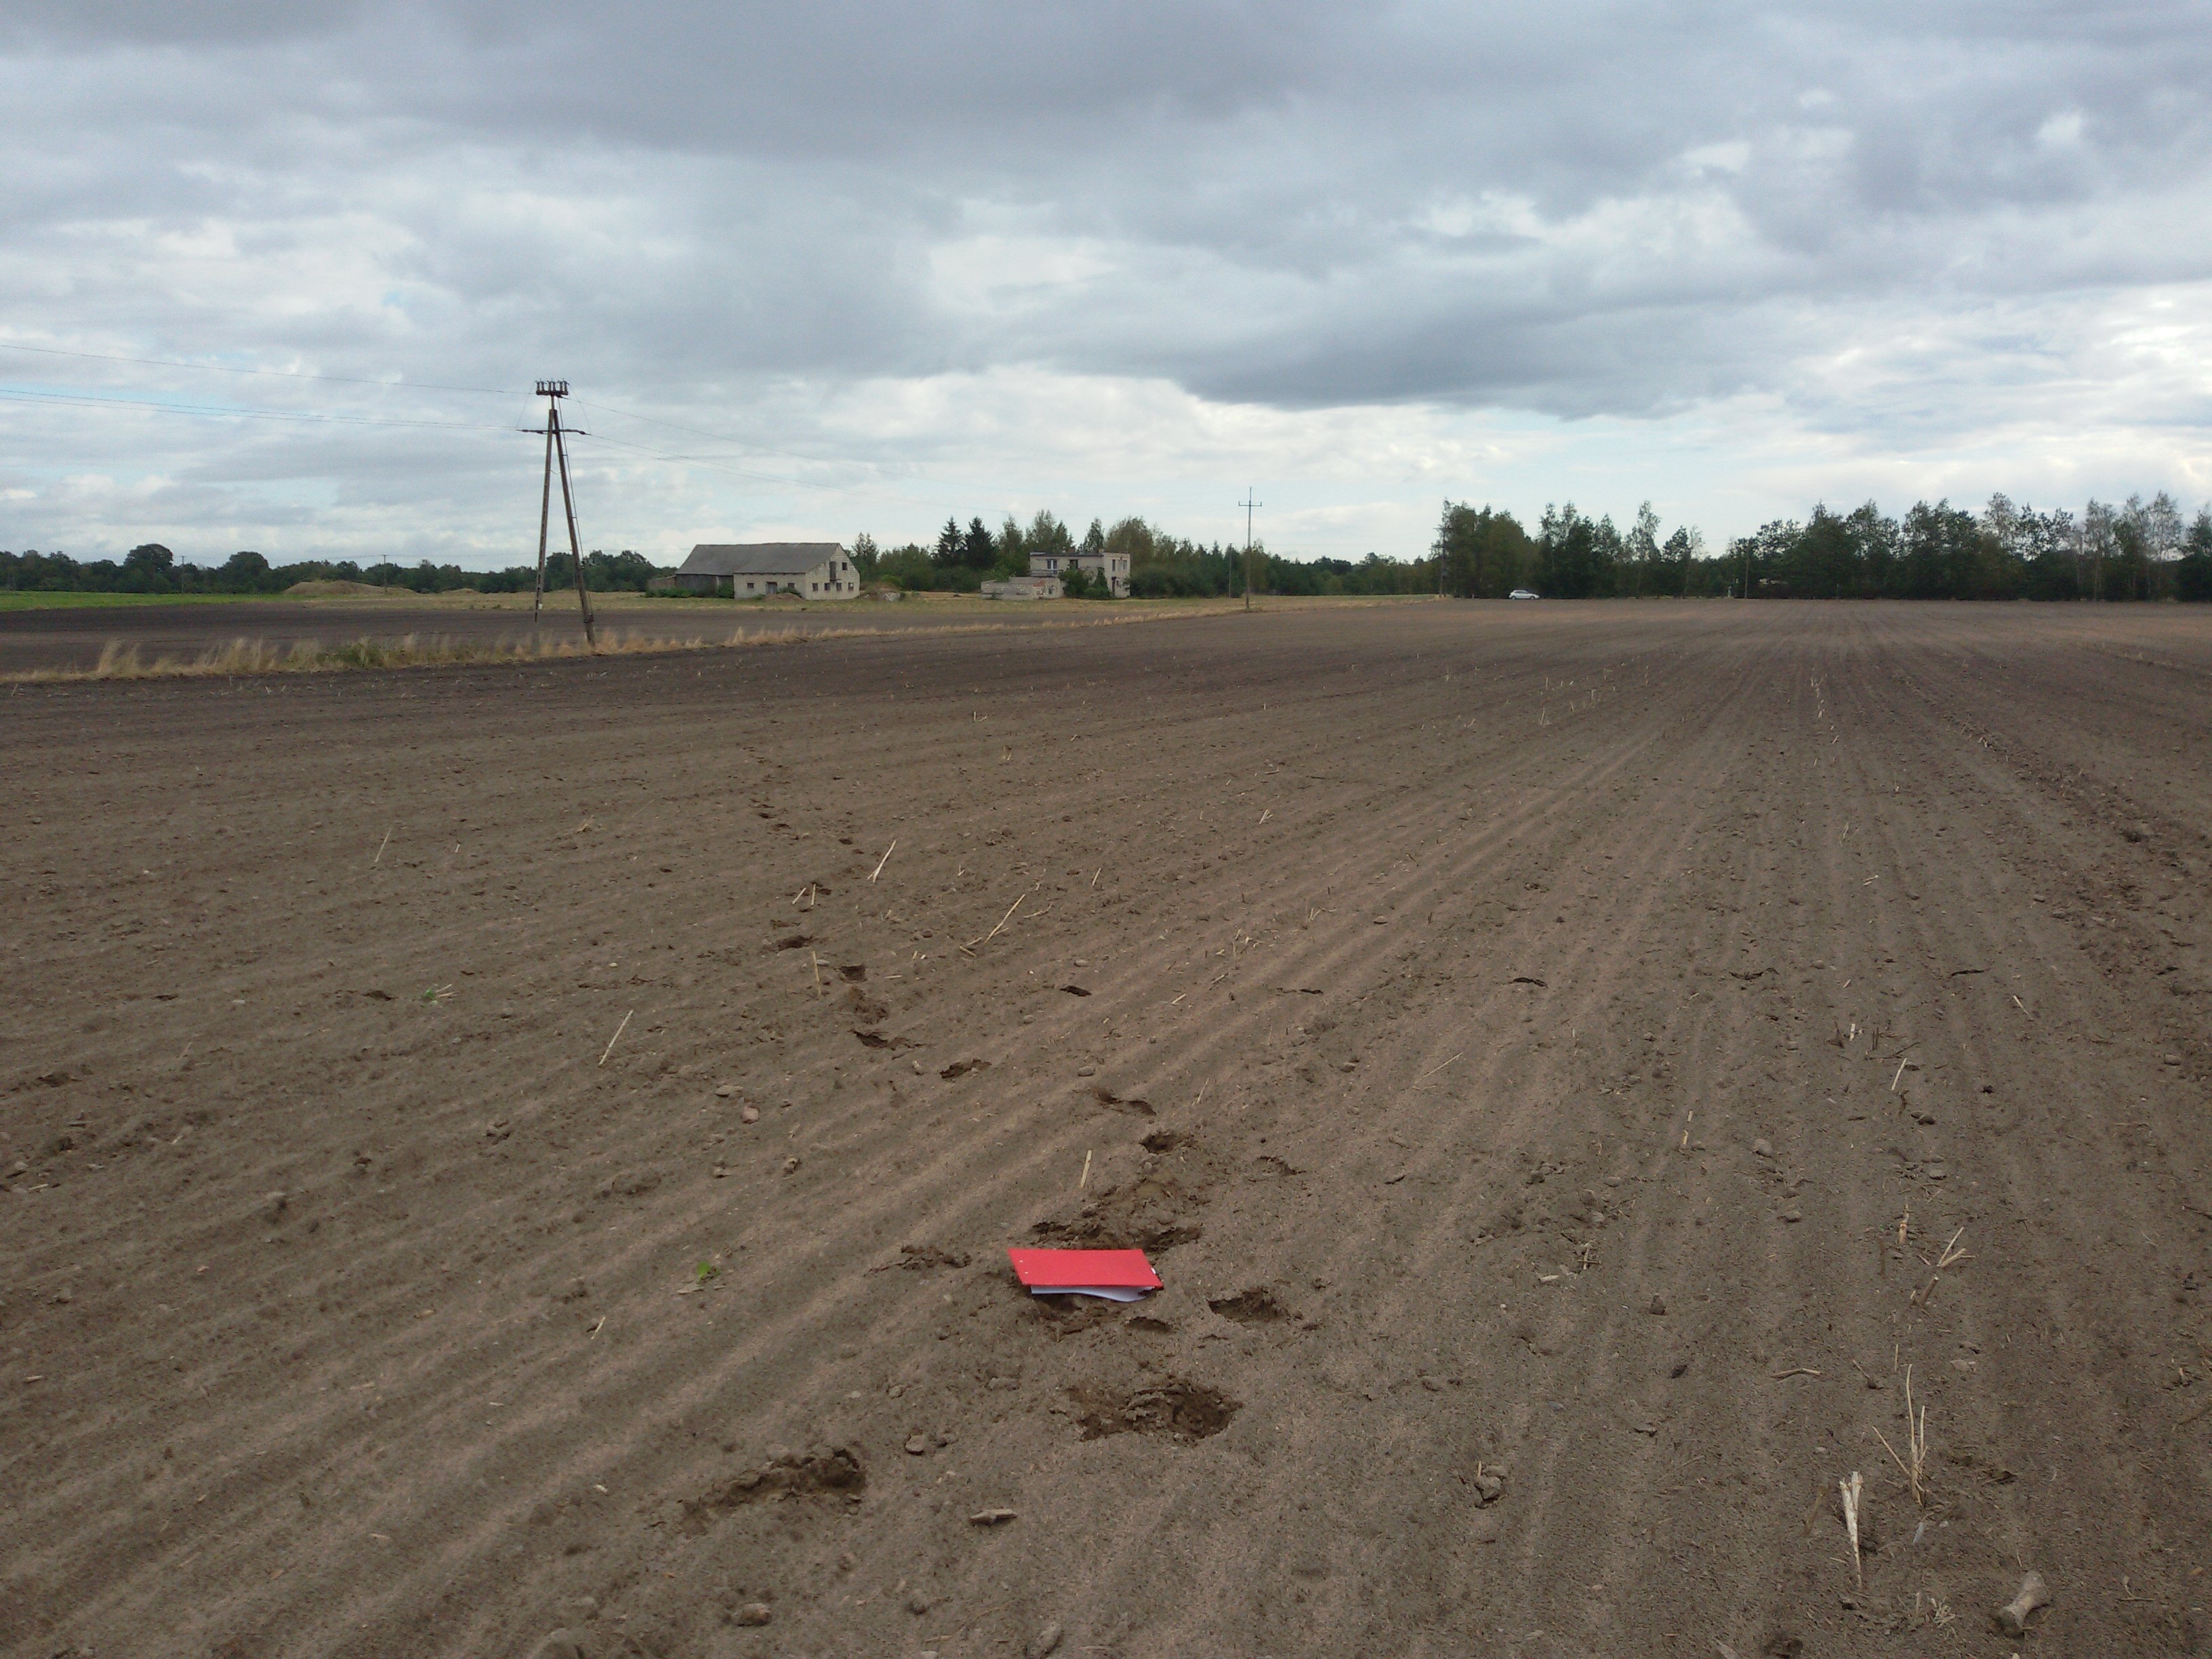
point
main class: Cropland
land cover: Rape and turnip rape
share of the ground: < 10 %
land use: Agriculture (excluding fallow land and kitchen gardens)
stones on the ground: < 10 %
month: September
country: PL
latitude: 52.7506
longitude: 17.5536
